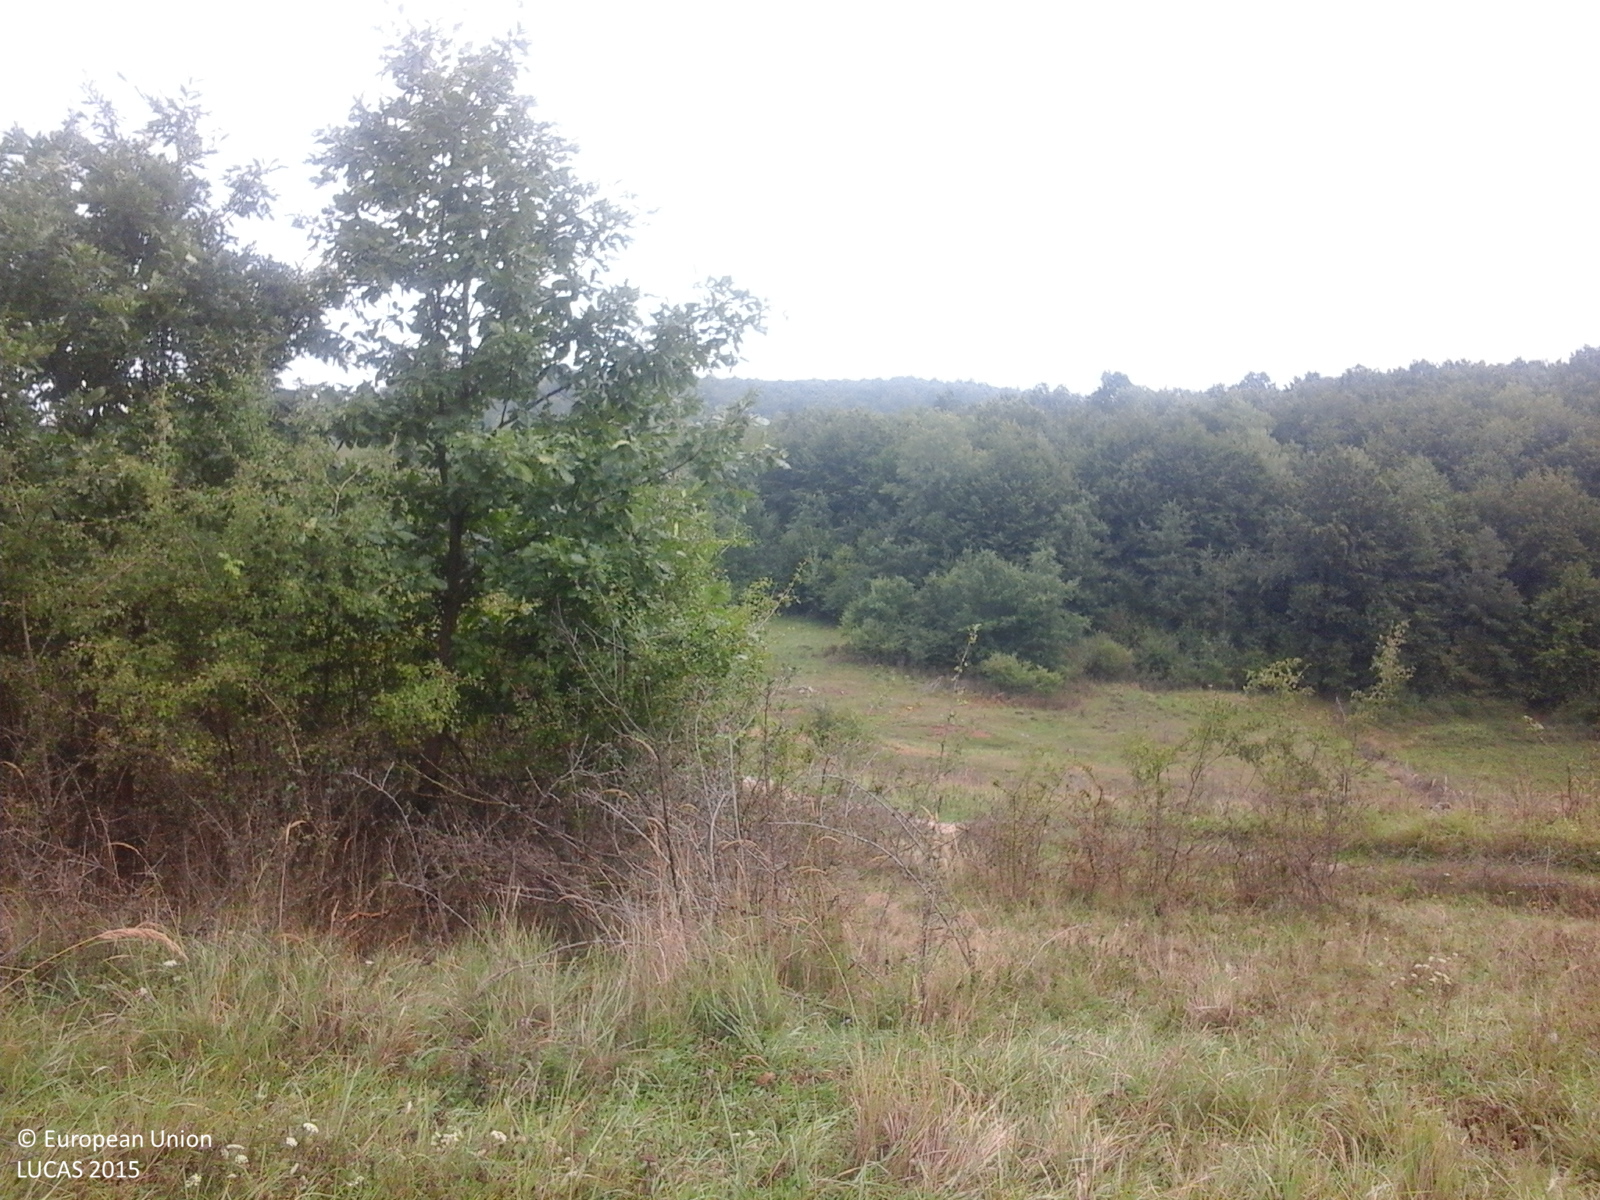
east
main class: Grassland
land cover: Grassland with sparse tree/shrub cover
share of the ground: > 75 %
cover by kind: herbaceous plants 85 %, shrubs 10 %, broadleaved forest trees 5 %
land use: Fallow land
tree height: < 5 m
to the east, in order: Grassland with sparse tree/shrub cover; Shrubland with sparse tree cover; Grassland with sparse tree/shrub cover; Tracks; Grassland with sparse tree/shrub cover; Broadleaved woodland; Grassland with sparse tree/shrub cover; Broadleaved woodland
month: September
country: RO
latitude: 46.9448
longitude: 22.4953
